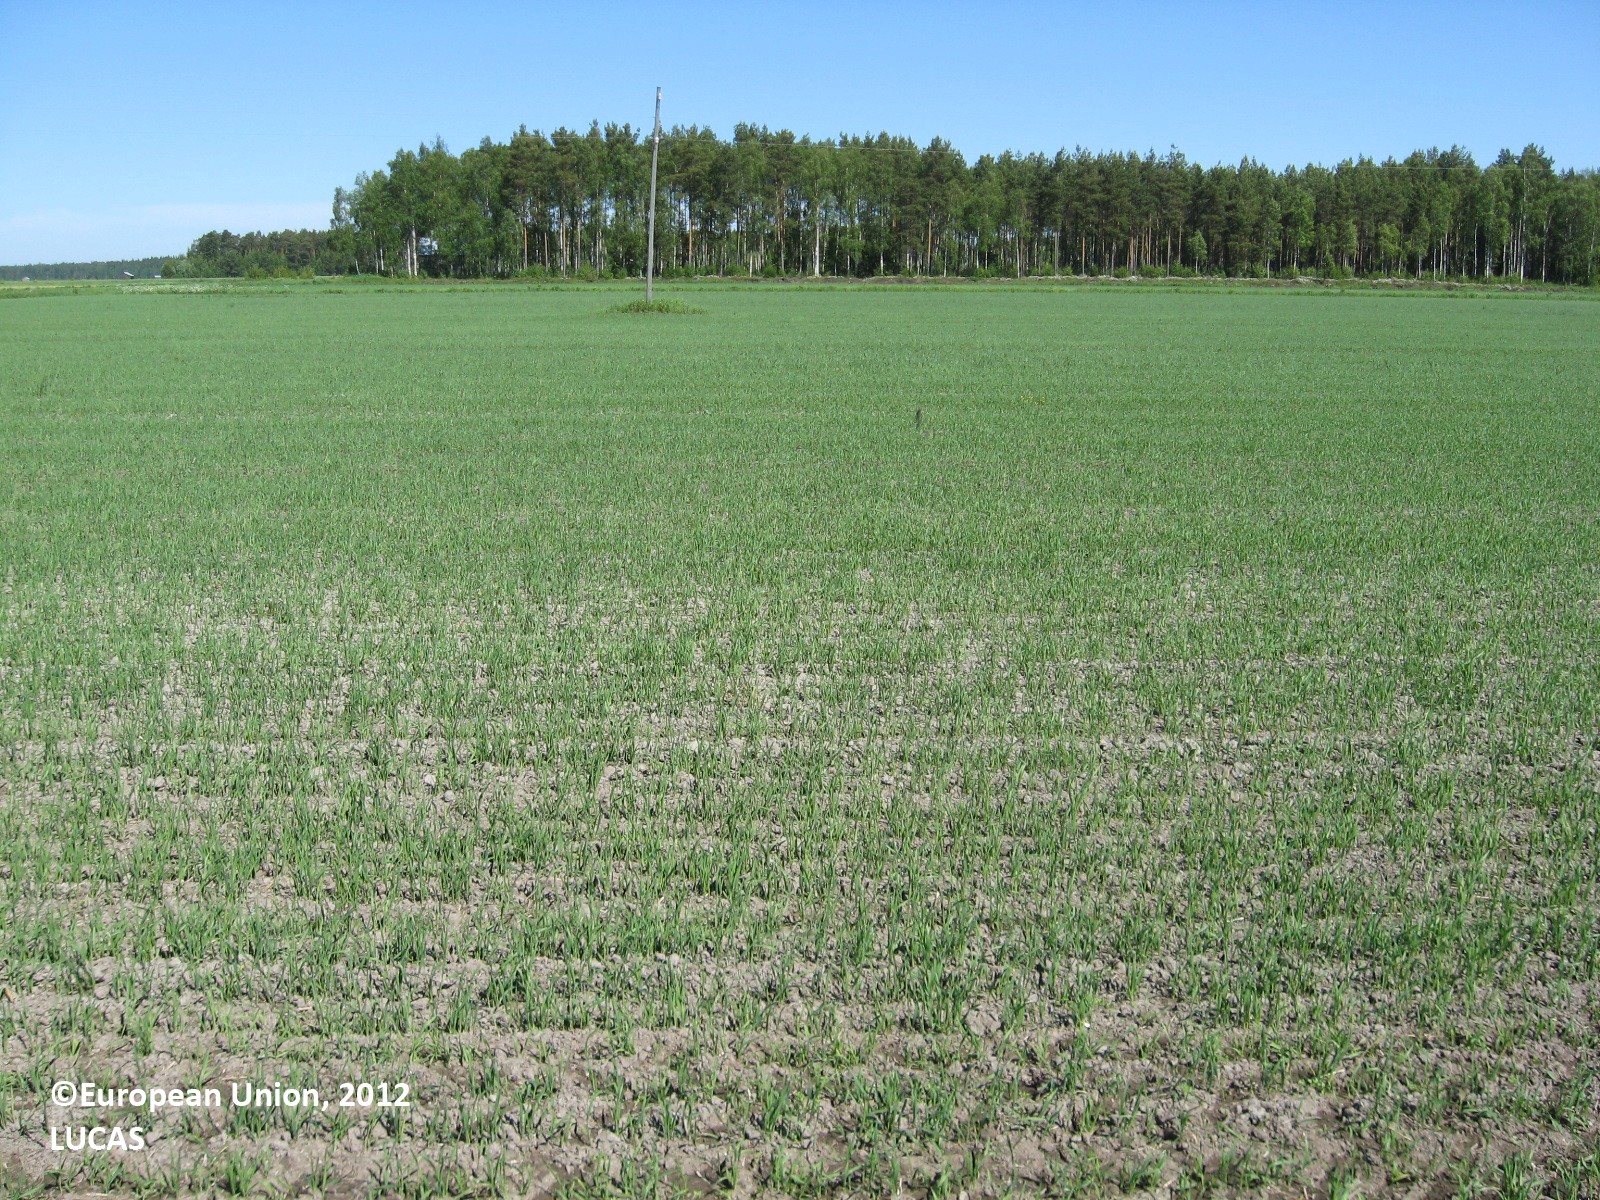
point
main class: Cropland
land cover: Oats
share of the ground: 25 - 50 %
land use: Agriculture (excluding fallow land and kitchen gardens)
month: June
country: FI
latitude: 62.9027
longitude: 21.7118
